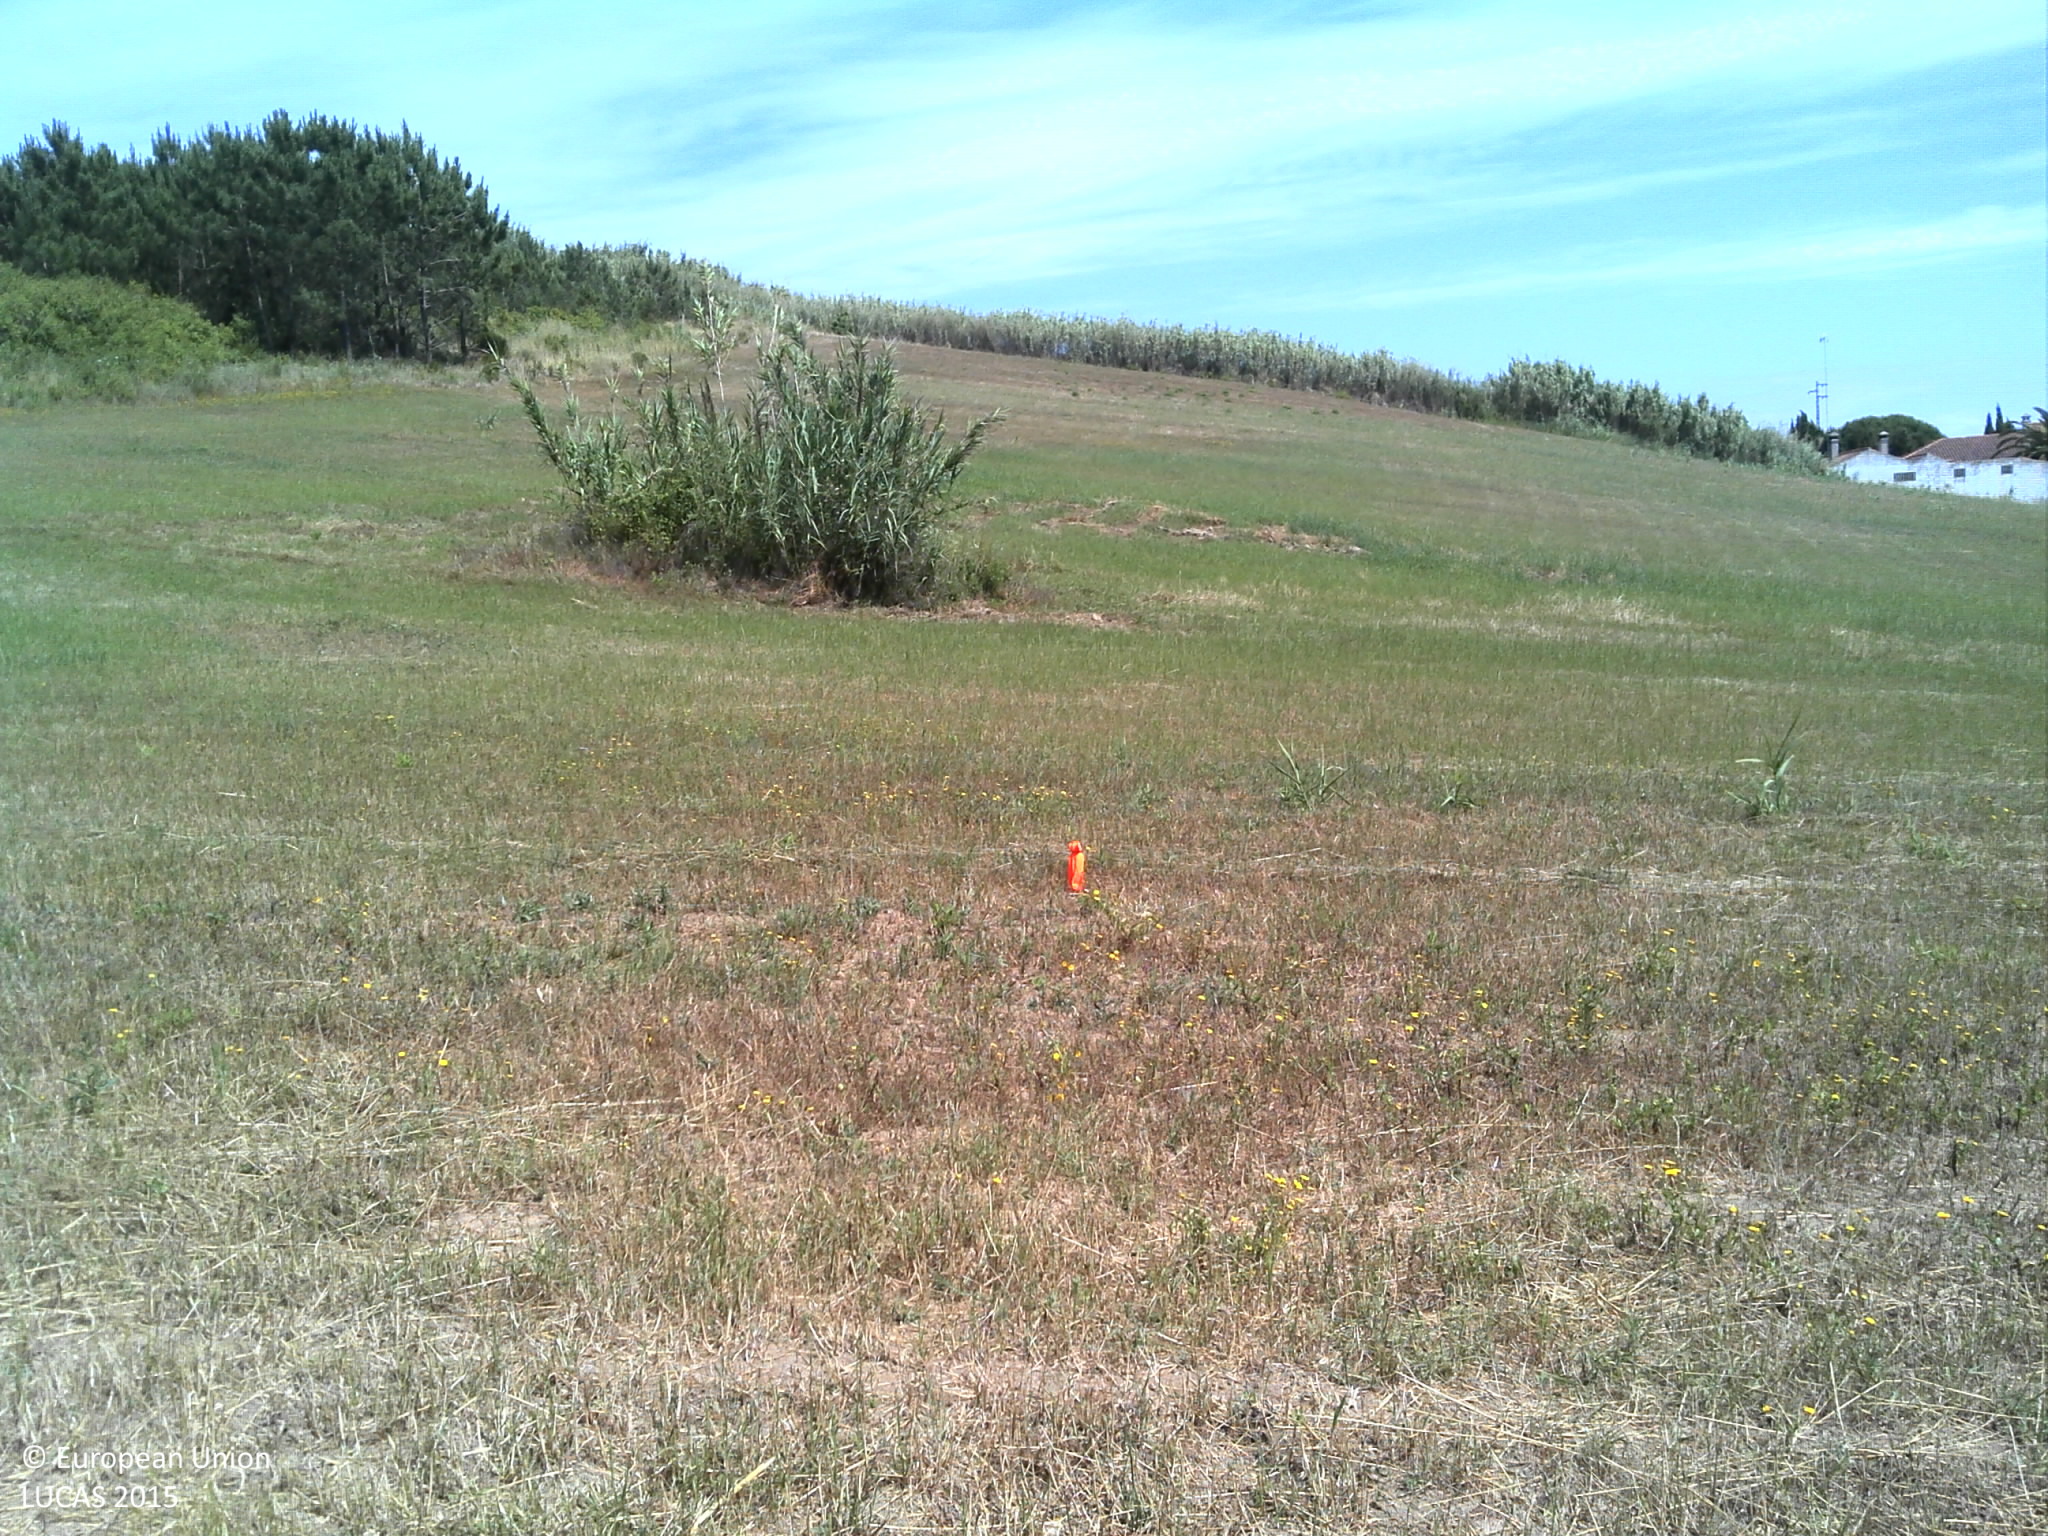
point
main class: Grassland
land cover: Grassland without tree/shrub cover
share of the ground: 50 - 75 %
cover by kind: herbaceous plants 70 %, unconsolidated bare surface 25 %, shrubs 5 %
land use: Agriculture (excluding fallow land and kitchen gardens)
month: June
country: PT
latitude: 39.2540
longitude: -9.3162
